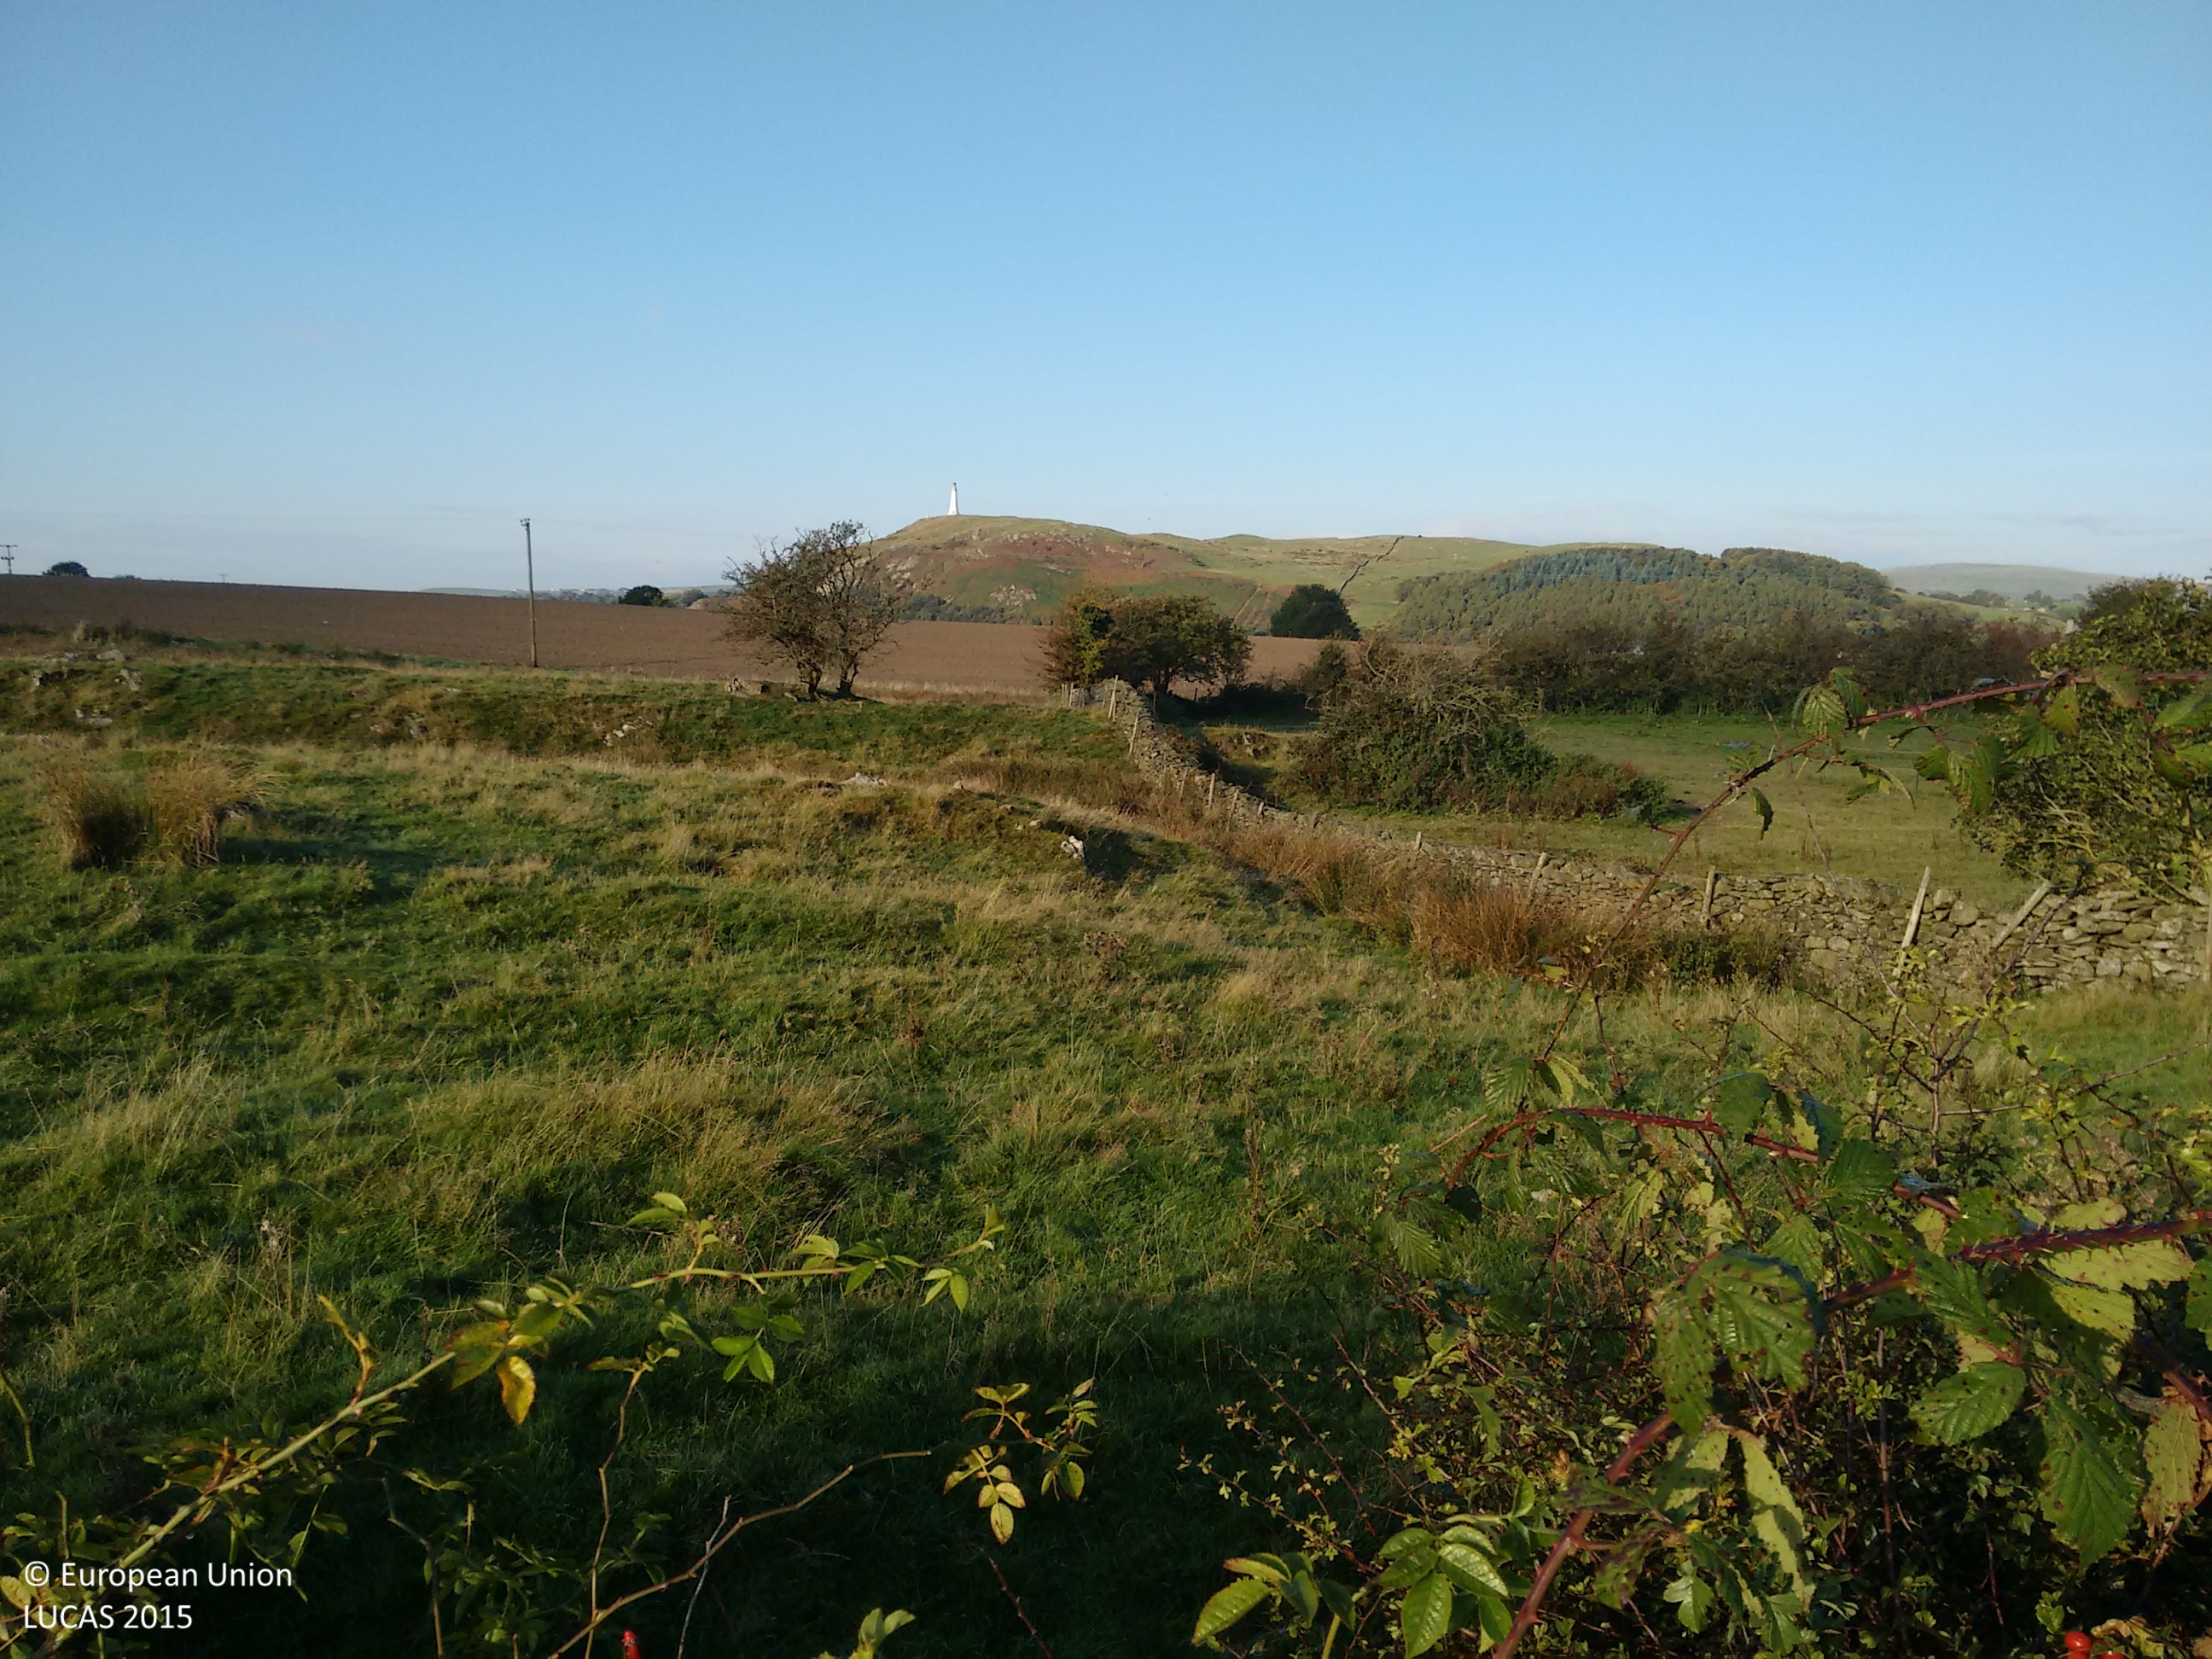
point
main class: Grassland
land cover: Grassland without tree/shrub cover
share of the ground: > 75 %
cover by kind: herbaceous plants 100 %
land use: Agriculture (excluding fallow land and kitchen gardens)
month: October
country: GB
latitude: 54.2037
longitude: -3.0592
